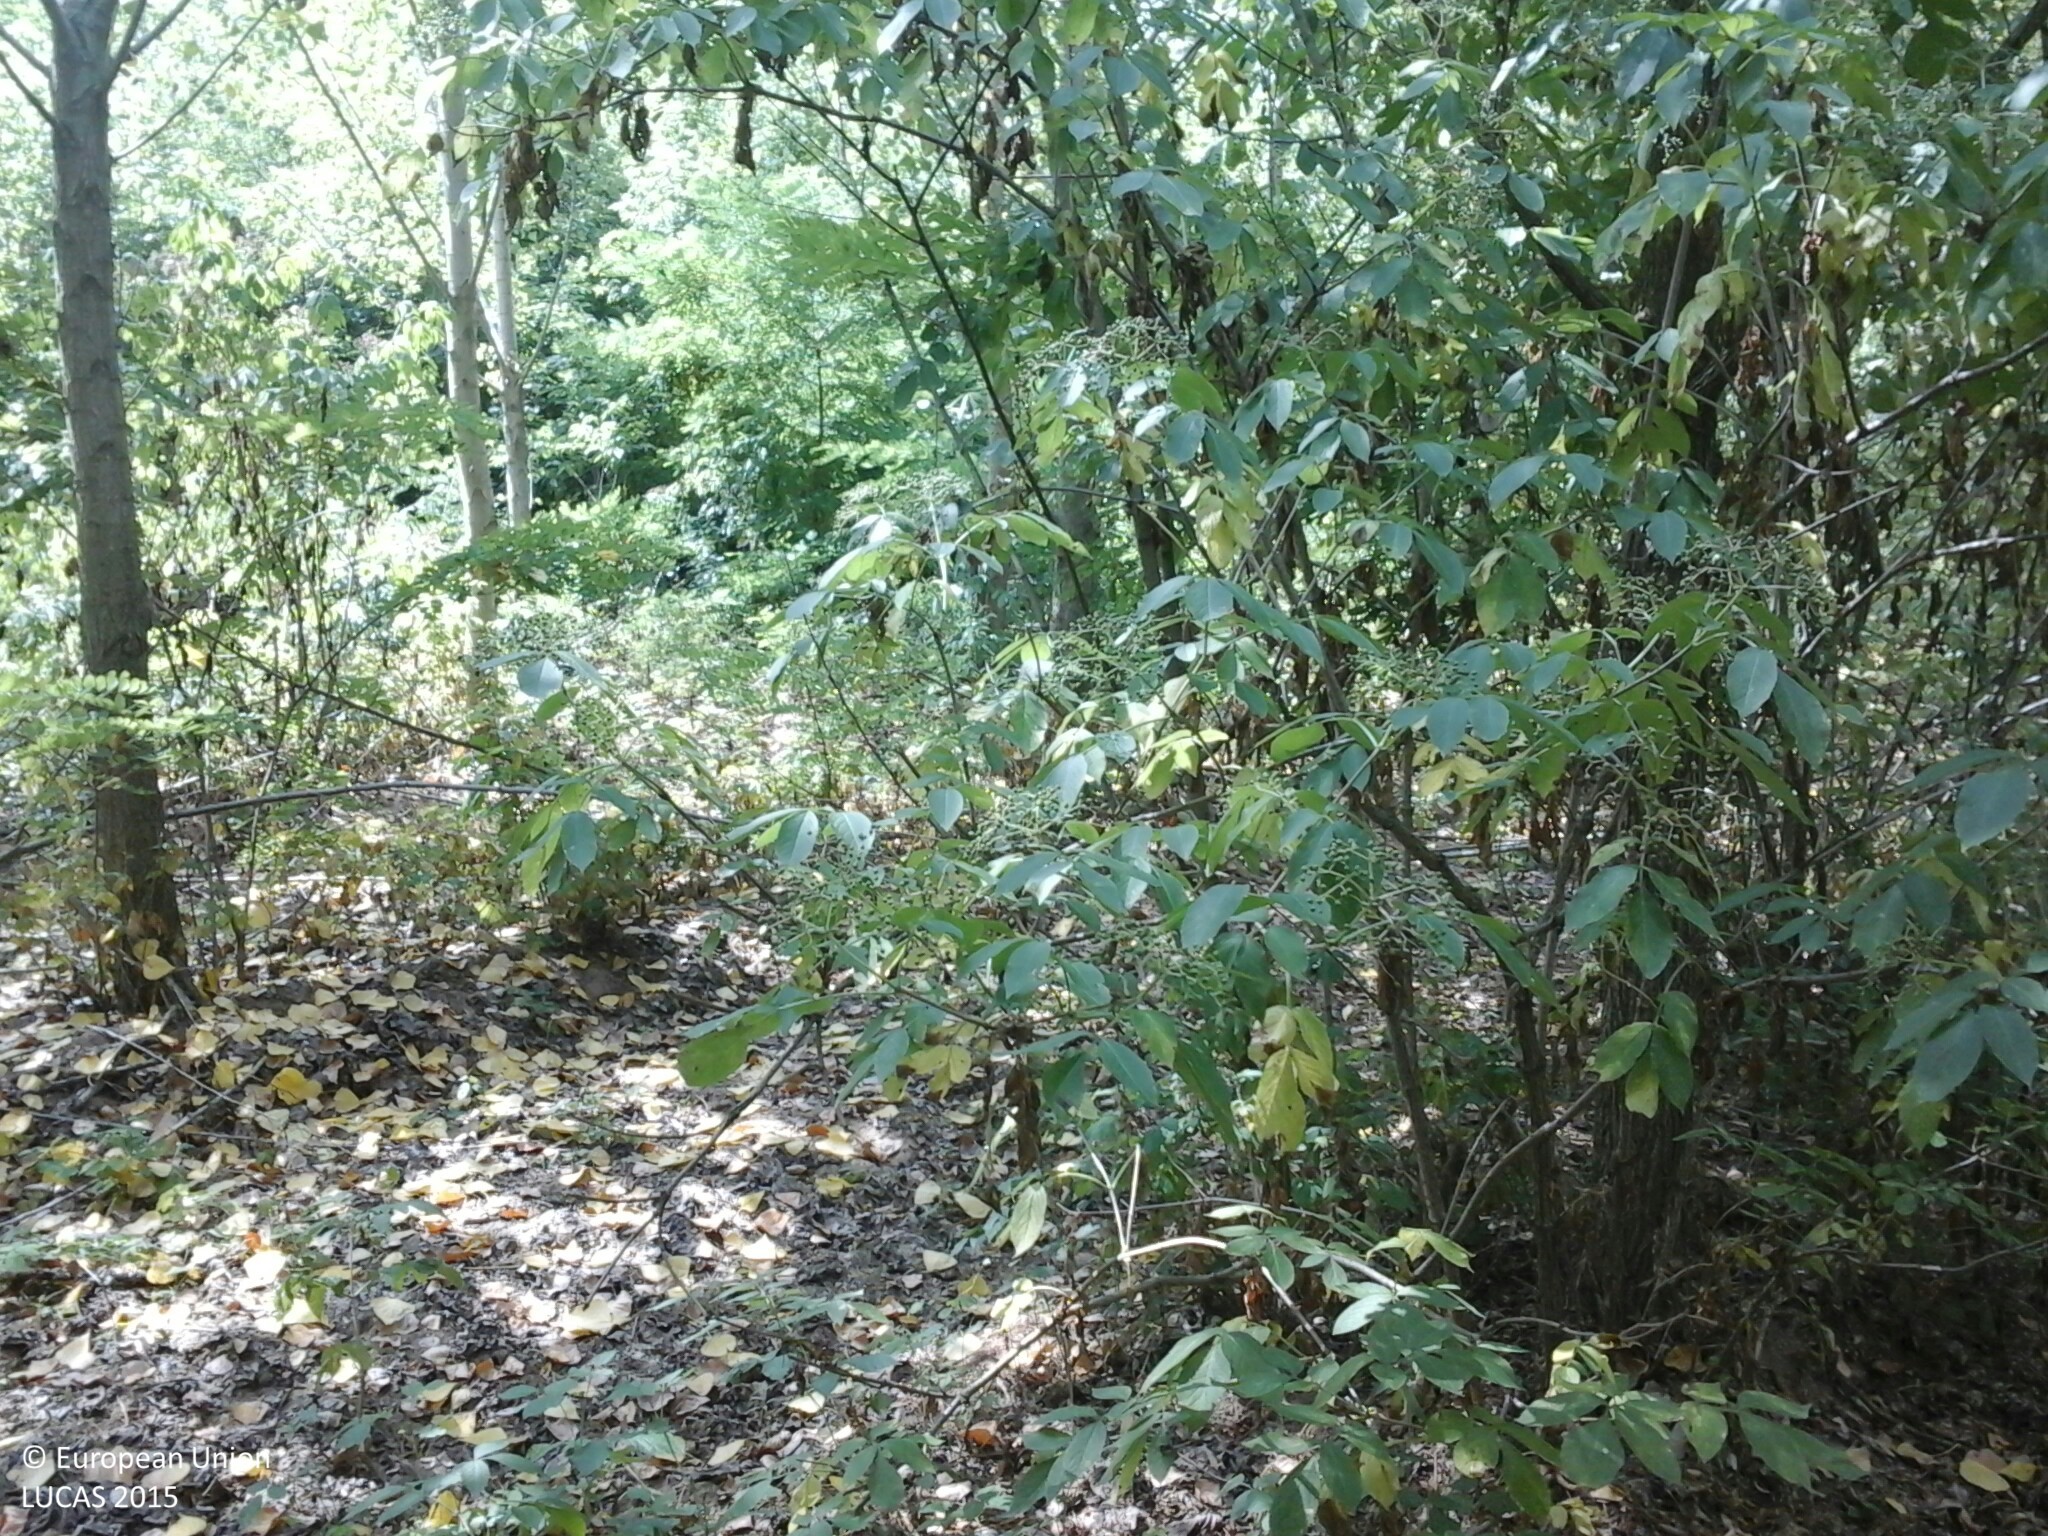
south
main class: Woodland
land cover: Broadleaved woodland
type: floodplain forest
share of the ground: > 75 %
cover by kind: broadleaved forest trees 100 %
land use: Forestry
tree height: > 5 m
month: July
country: HU
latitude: 48.3923
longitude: 22.2526
